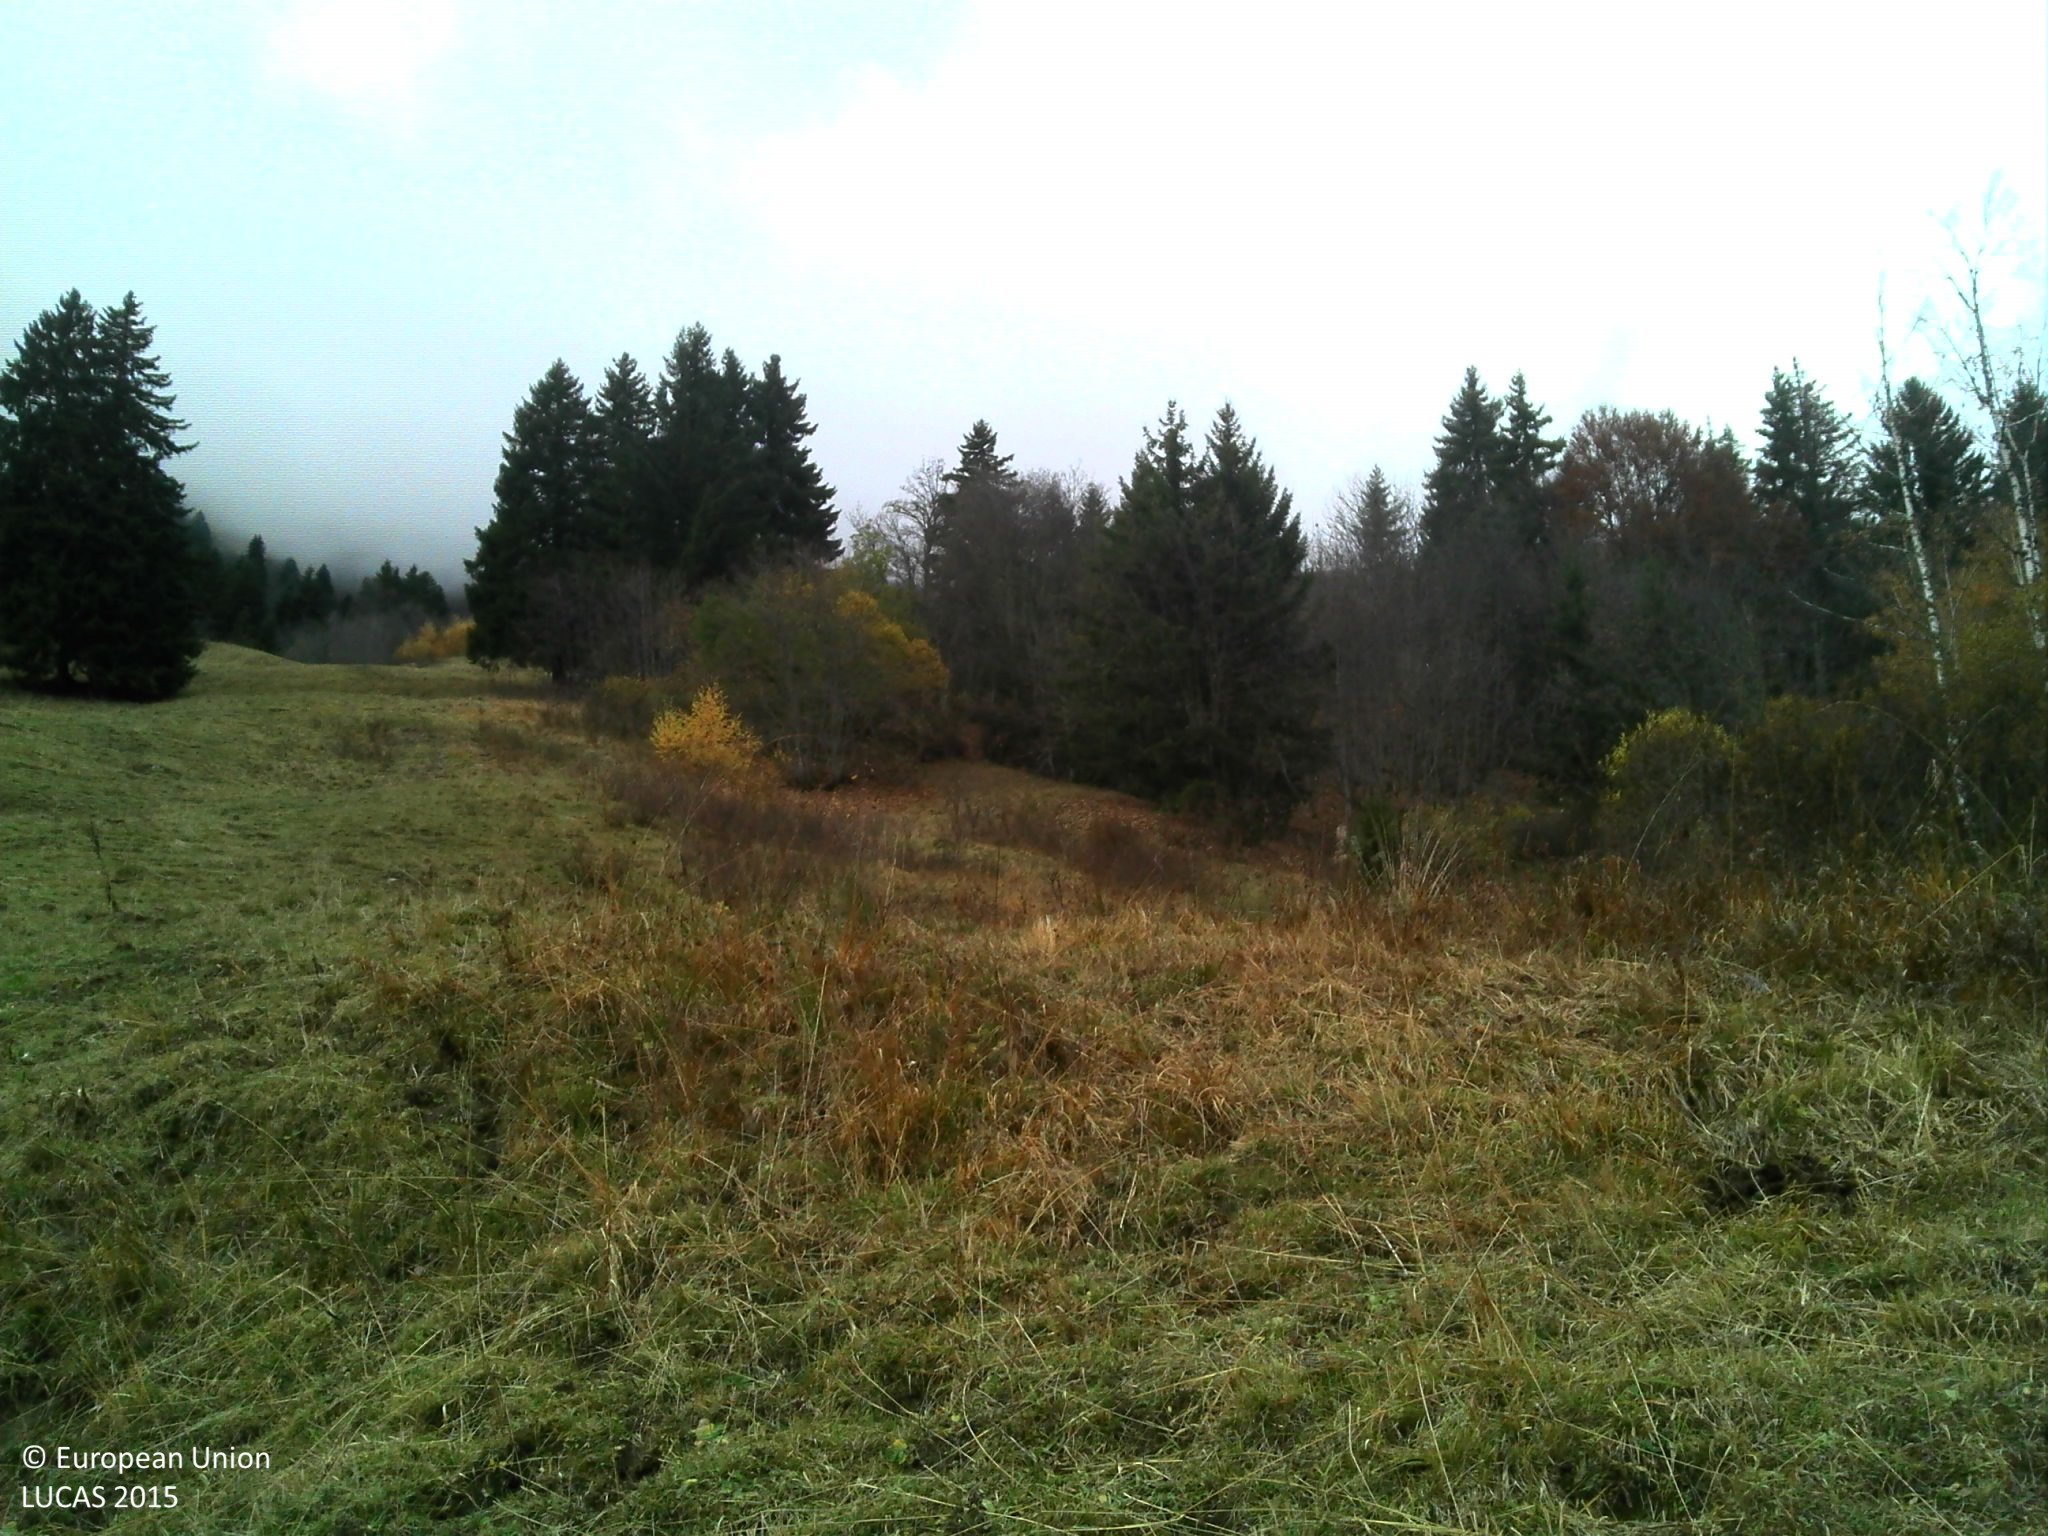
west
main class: Grassland
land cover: Grassland without tree/shrub cover
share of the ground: > 75 %
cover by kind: herbaceous plants 95 %, shrubs 5 %
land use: Agriculture (excluding fallow land and kitchen gardens)
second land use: Sport
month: October
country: FR
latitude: 45.4623
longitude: 6.4365
